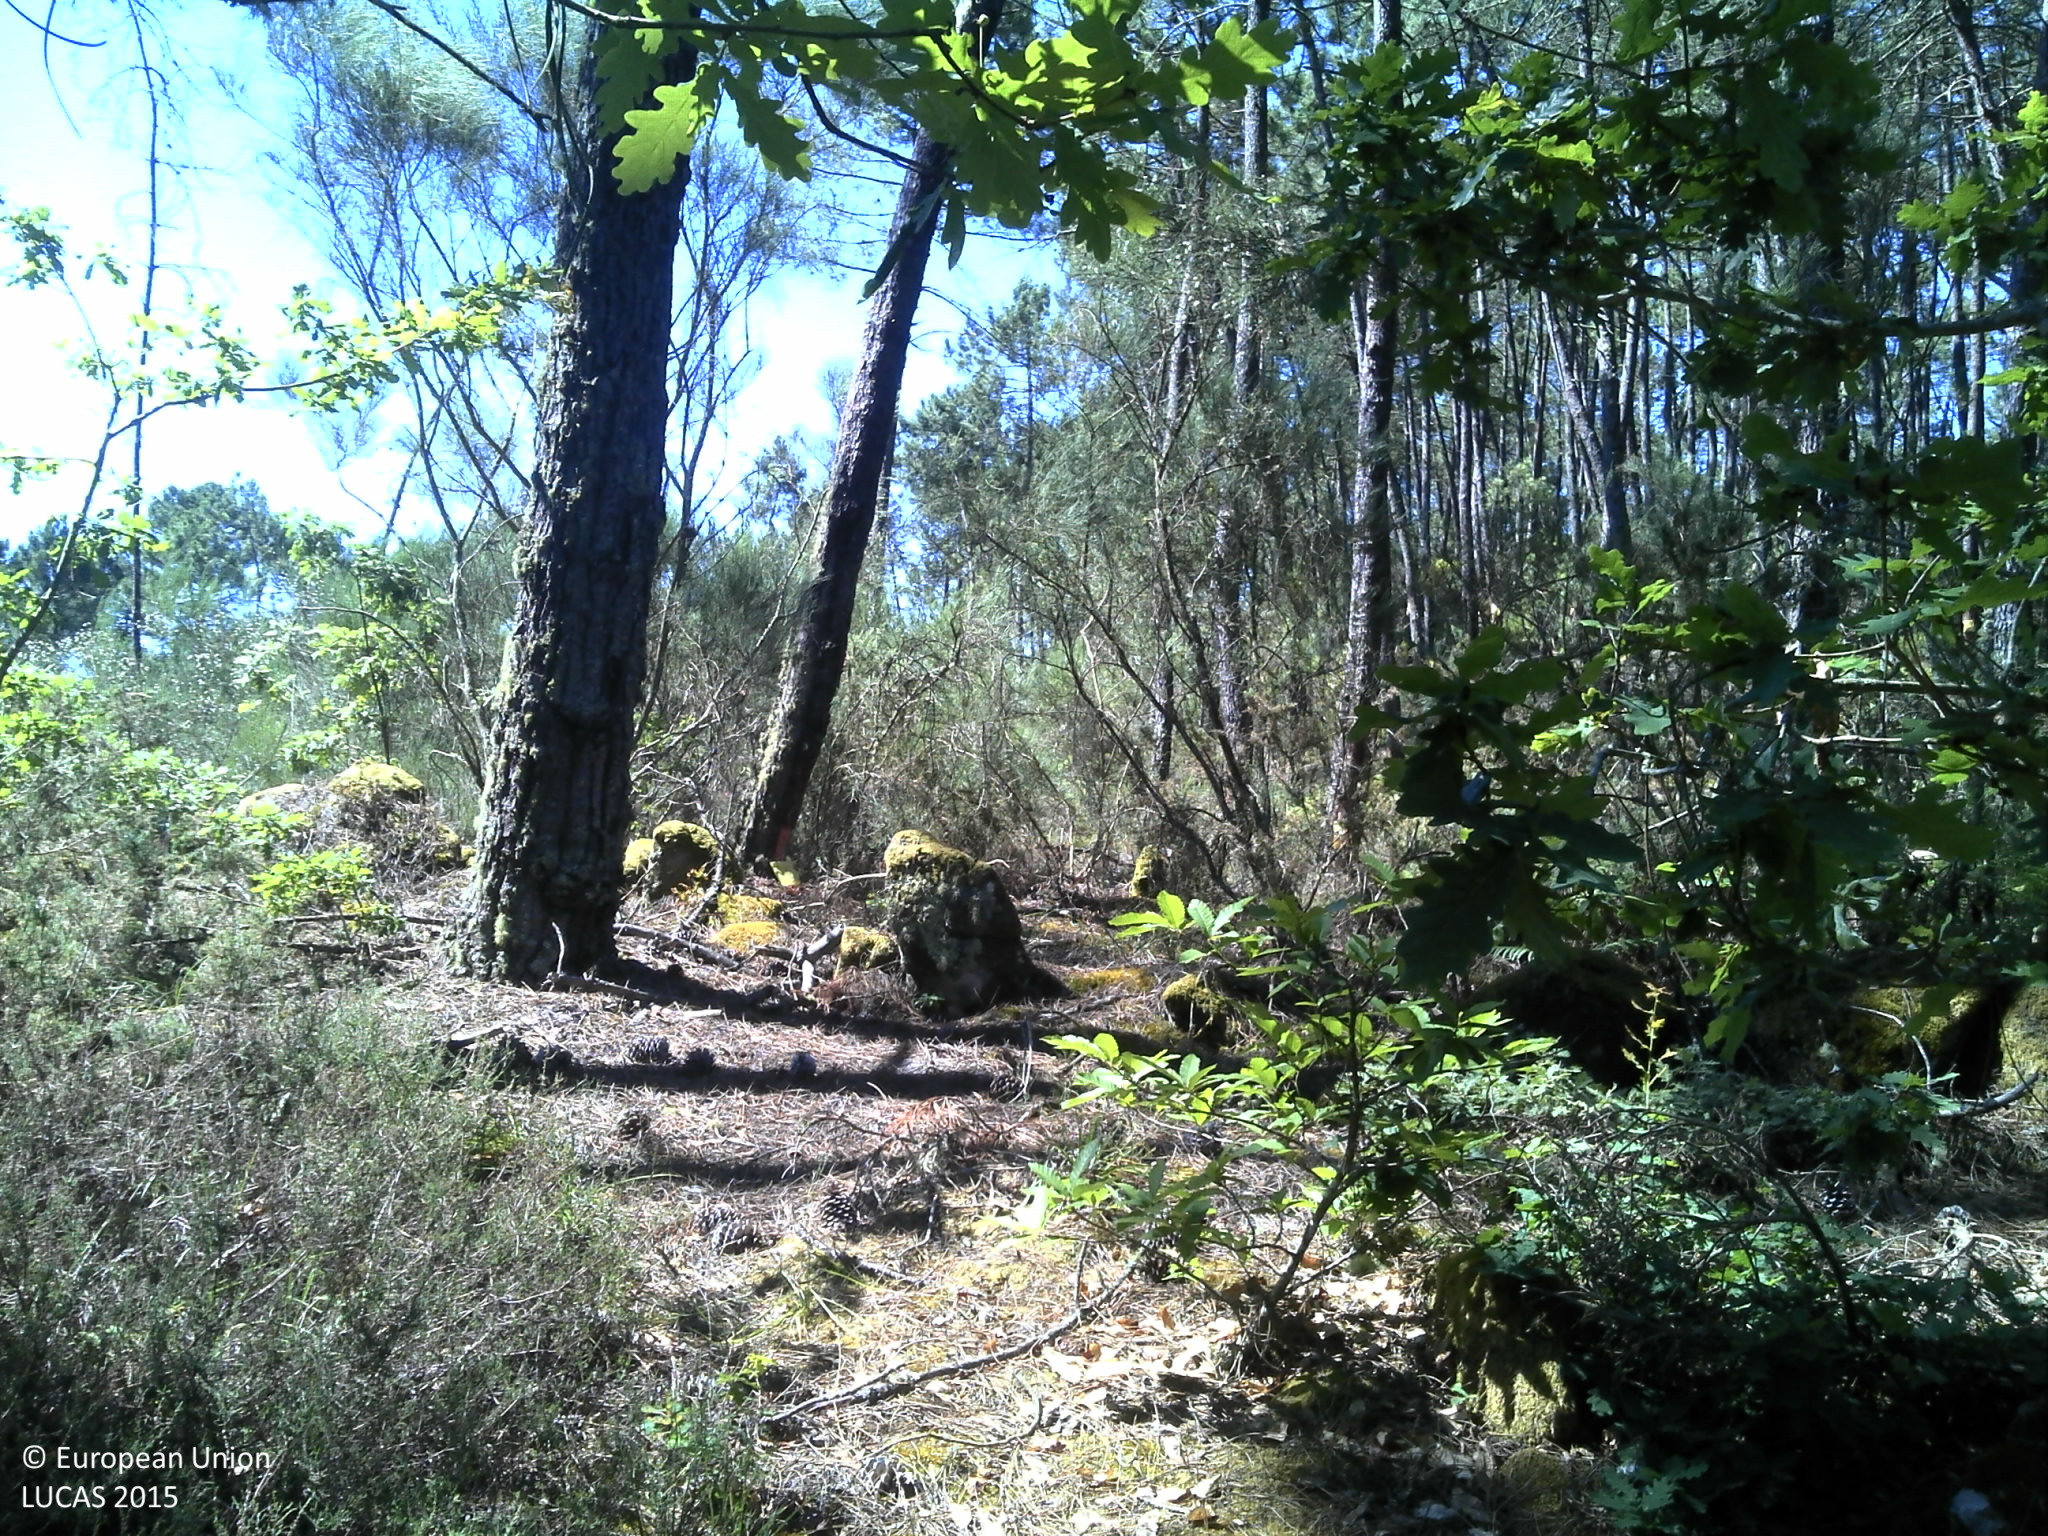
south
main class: Woodland
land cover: Pine dominated coniferous woodland
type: coniferous forest of the mediterranean region
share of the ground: > 75 %
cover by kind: coniferous forest trees 75 %, shrubs 15 %, unconsolidated bare surface 10 %
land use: Forestry
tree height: > 5 m
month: June
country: PT
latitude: 40.6875
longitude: -8.0311
